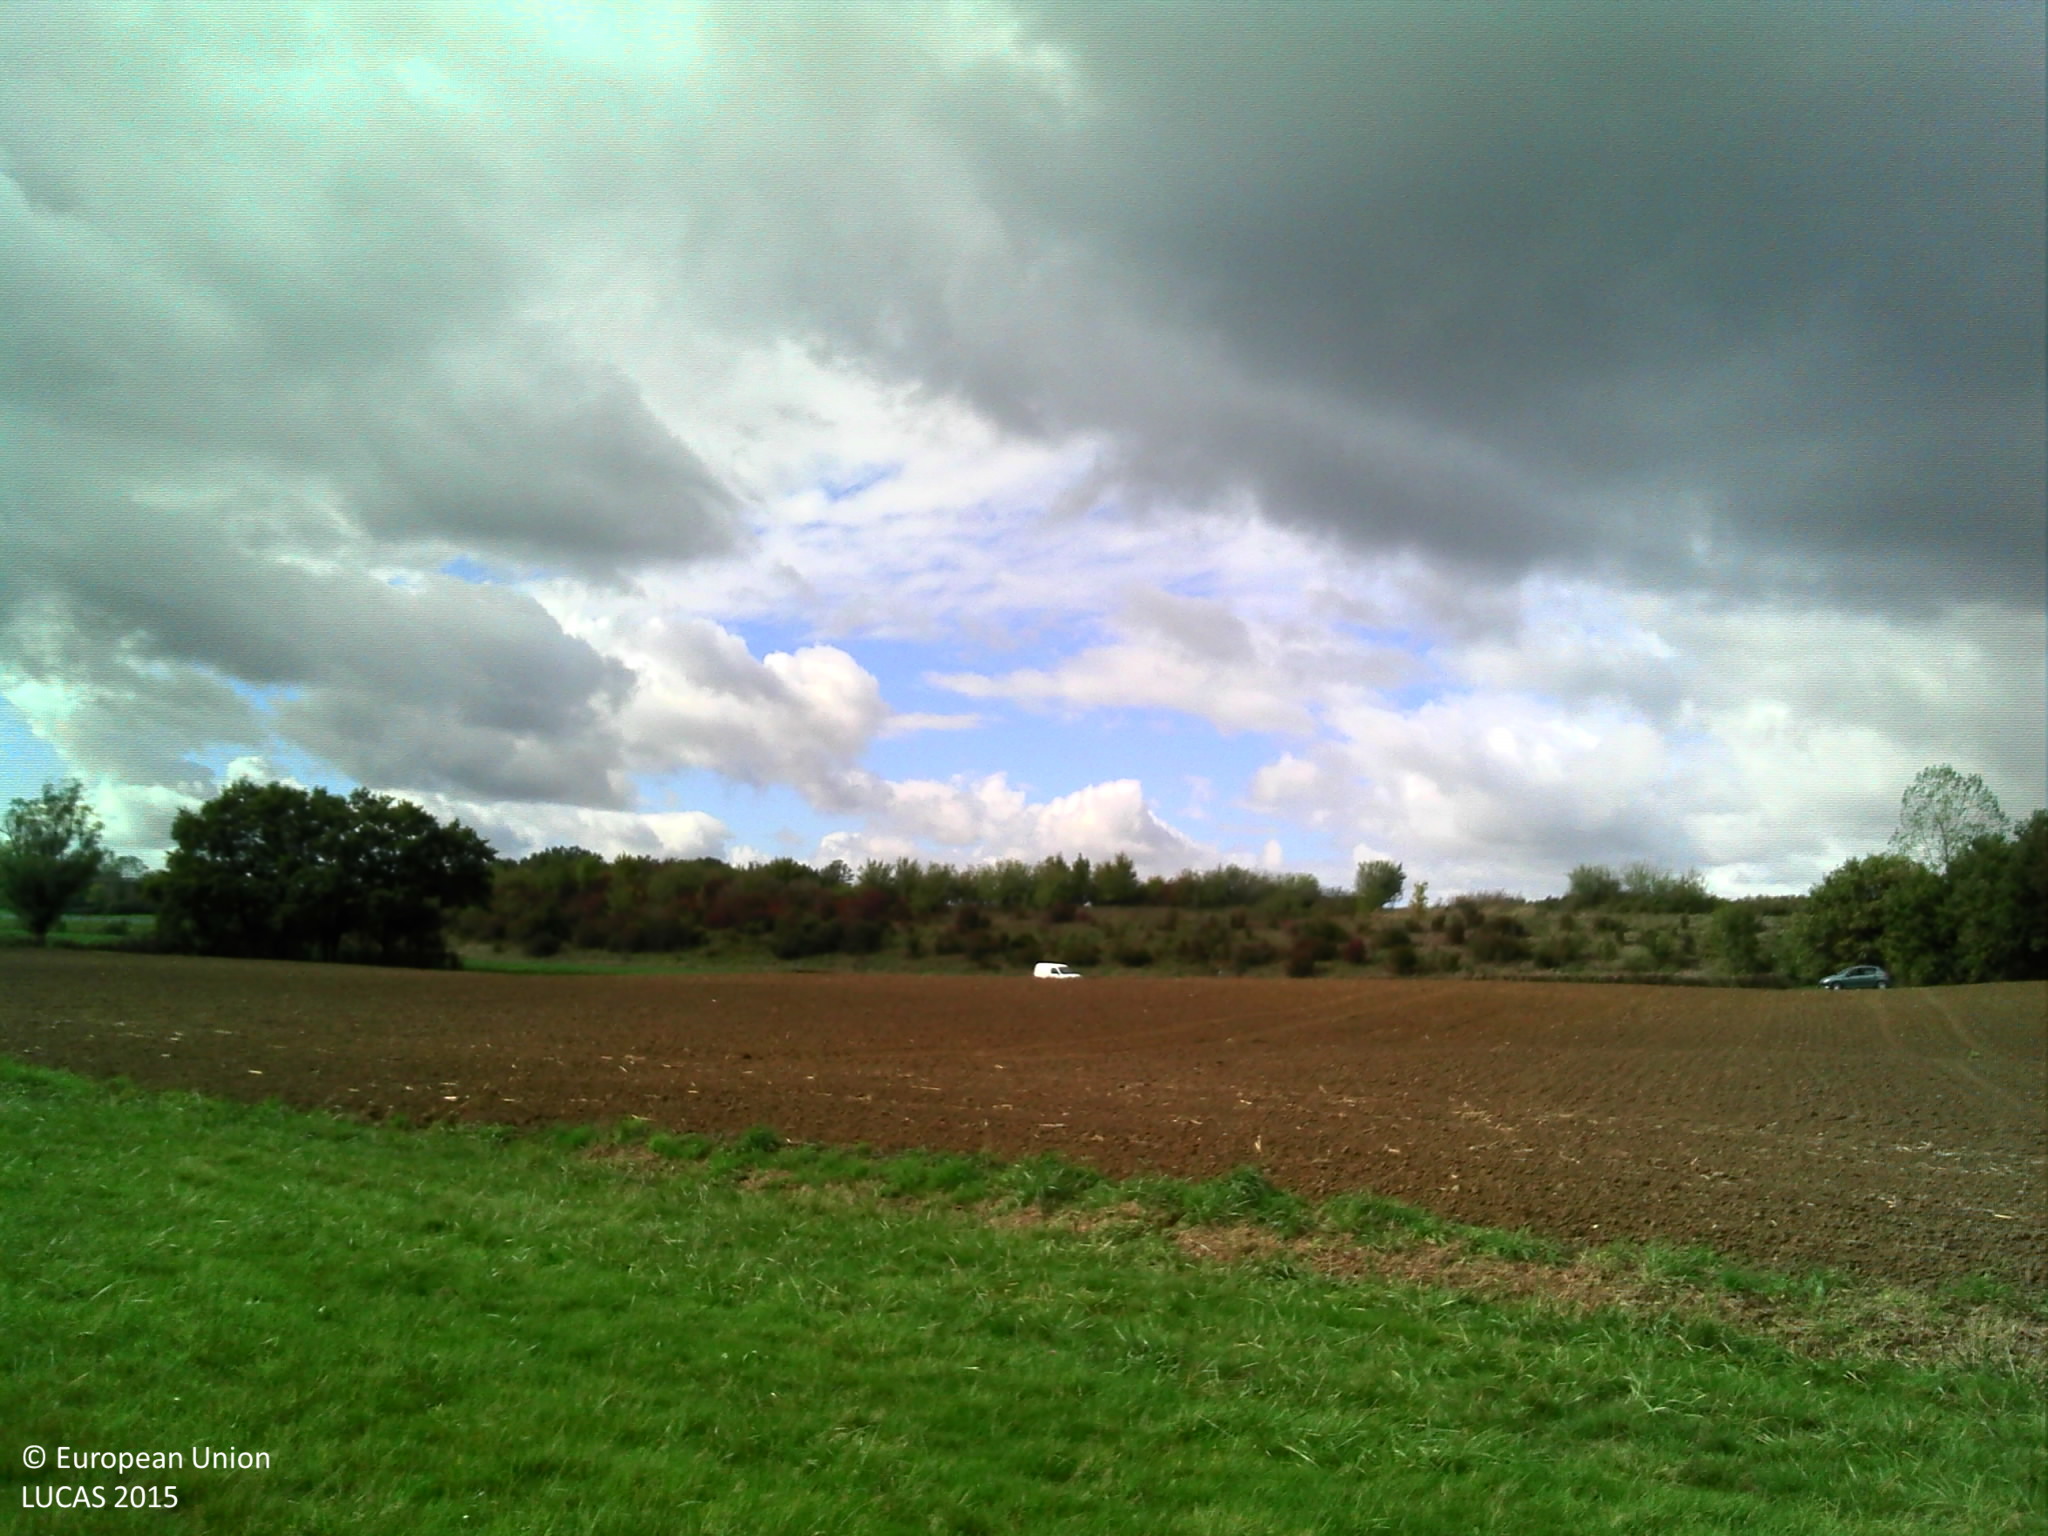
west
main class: Cropland
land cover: Temporary grasslands
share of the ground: > 75 %
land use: Agriculture (excluding fallow land and kitchen gardens)
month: October
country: FR
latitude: 46.4094
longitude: 5.2805
